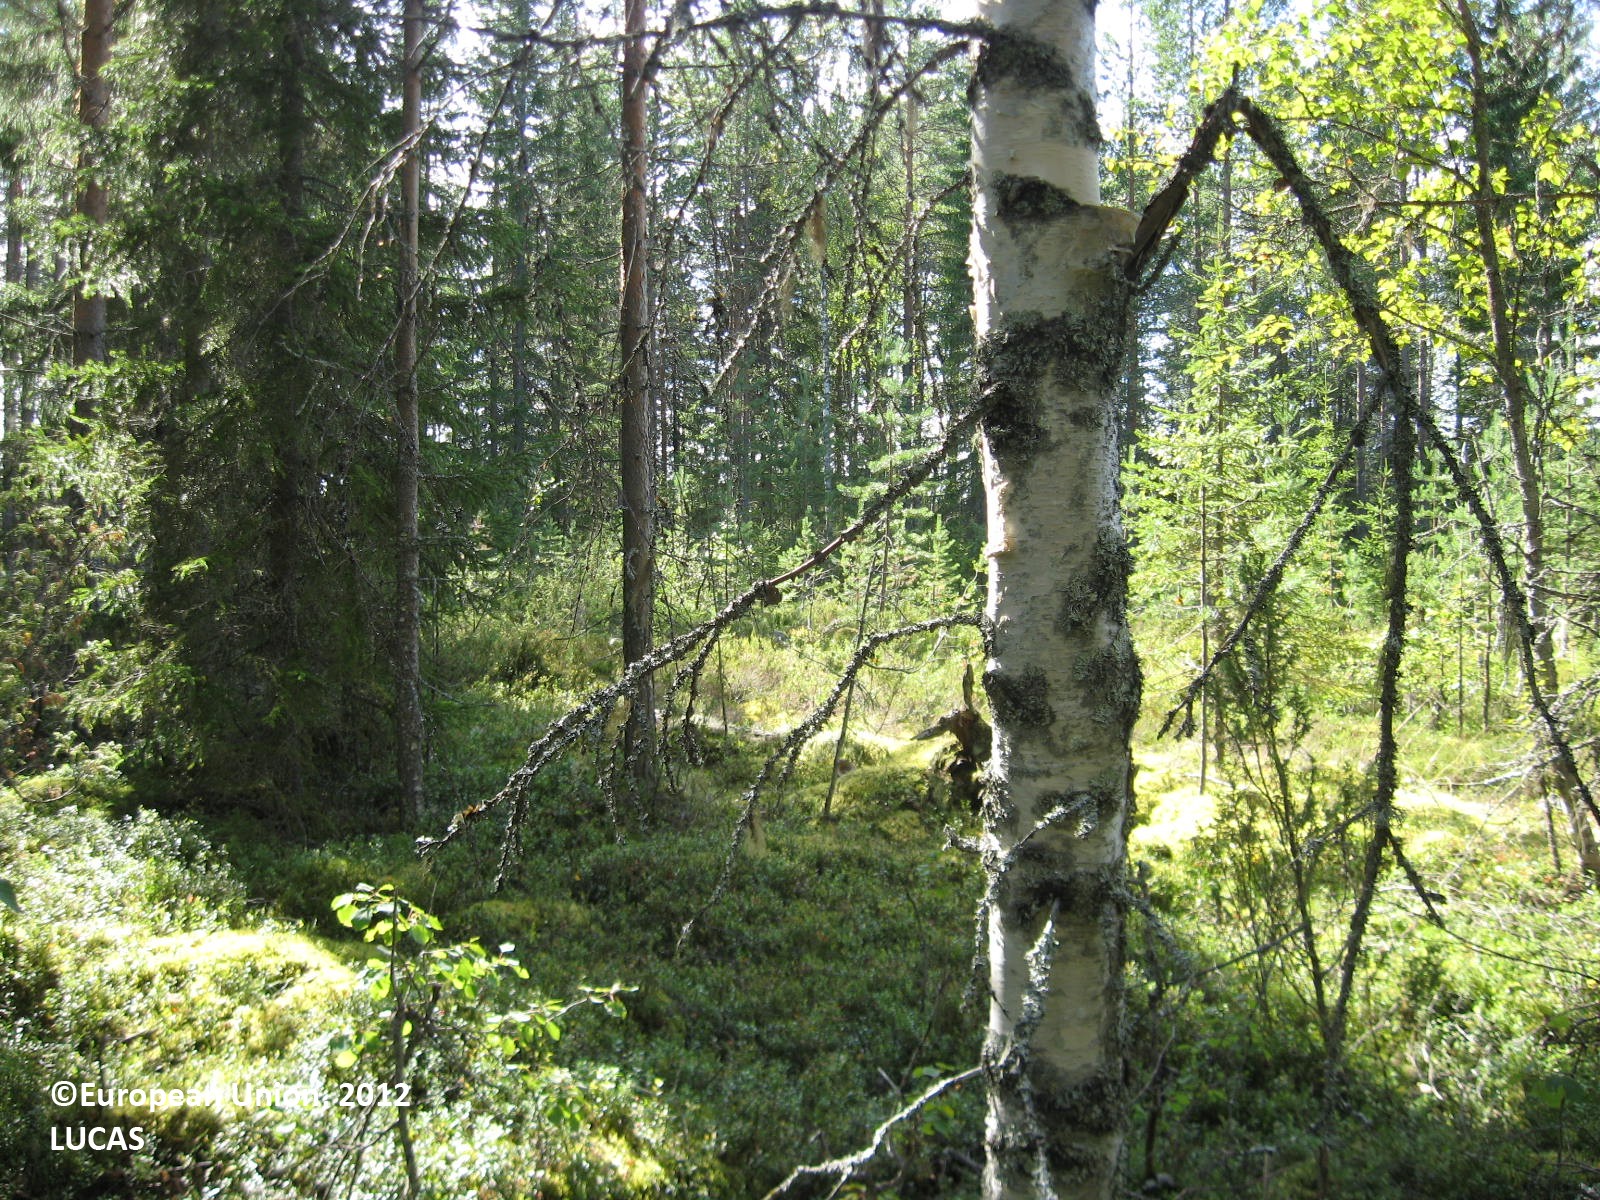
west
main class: Woodland
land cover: Pine dominated coniferous woodland
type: boreal forest
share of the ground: > 75 %
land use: Forestry
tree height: > 5 m
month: August
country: FI
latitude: 63.6454
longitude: 29.7179
